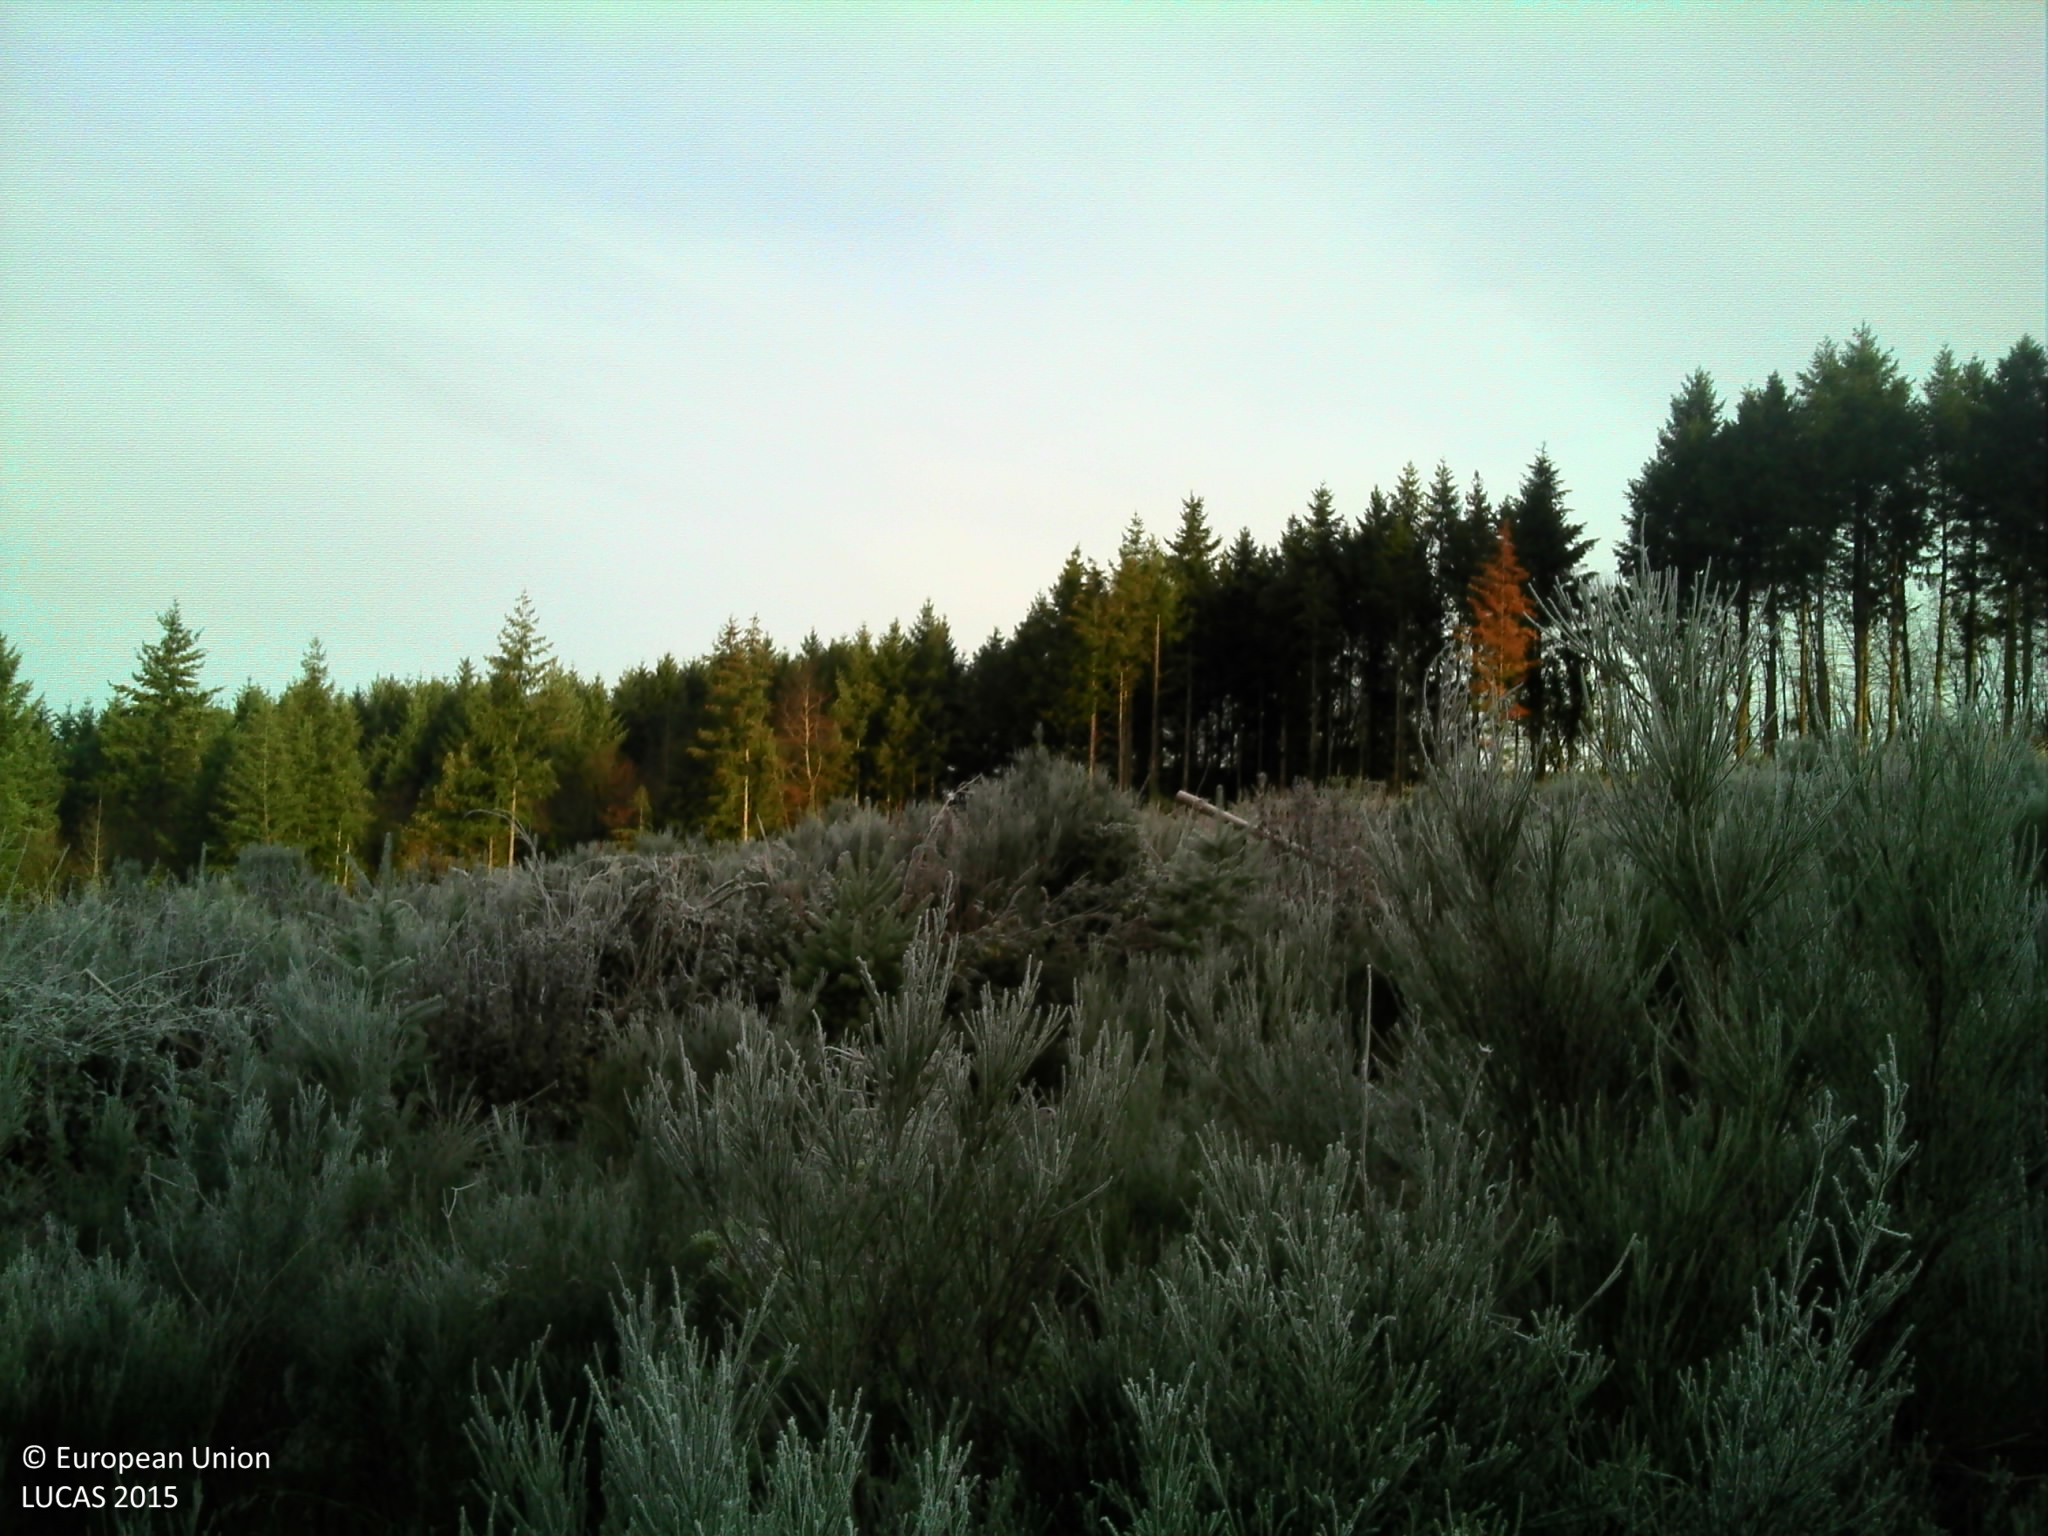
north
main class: Shrubland
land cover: Shrubland with sparse tree cover
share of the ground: > 75 %
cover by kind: shrubs 80 %, herbaceous plants 15 %, coniferous forest trees 5 %
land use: Forestry
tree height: < 5 m
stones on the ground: < 10 %
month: November
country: FR
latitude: 46.1830
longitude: 3.6911
